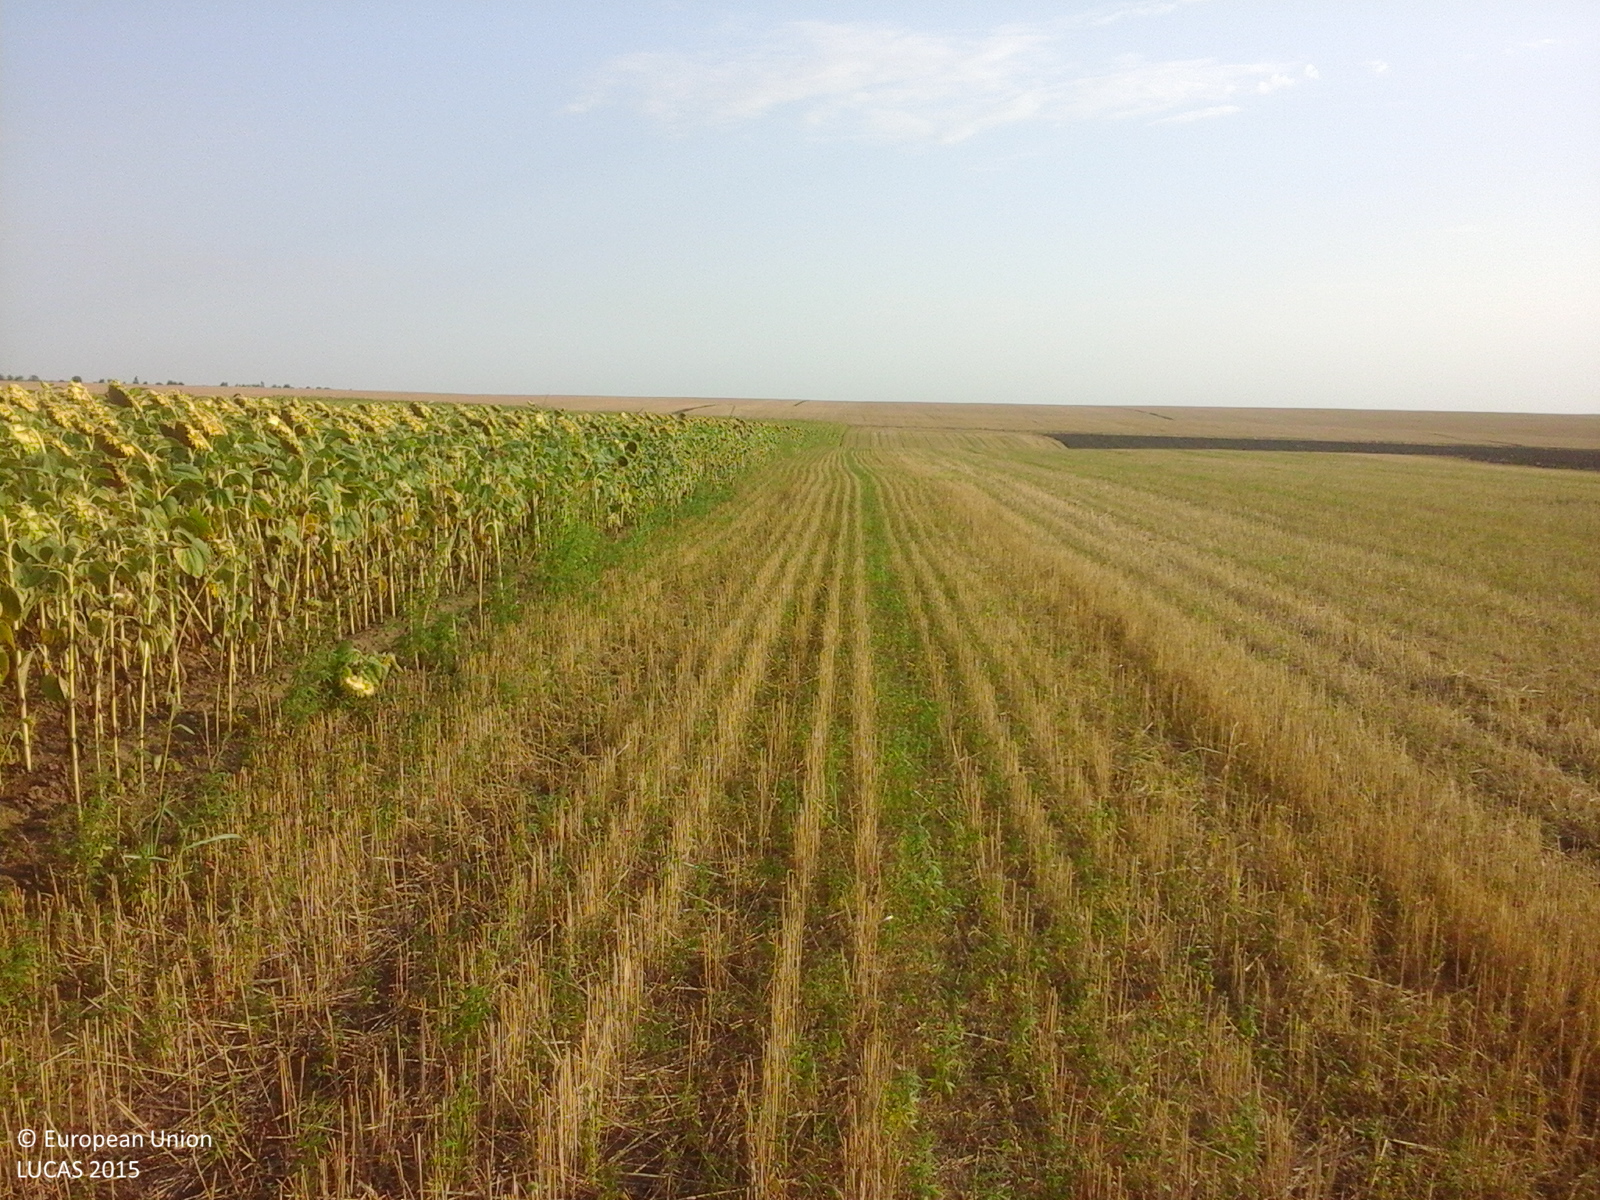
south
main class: Cropland
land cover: Sunflower
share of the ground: > 75 %
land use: Agriculture (excluding fallow land and kitchen gardens)
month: August
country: RO
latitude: 44.0624
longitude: 28.0435
